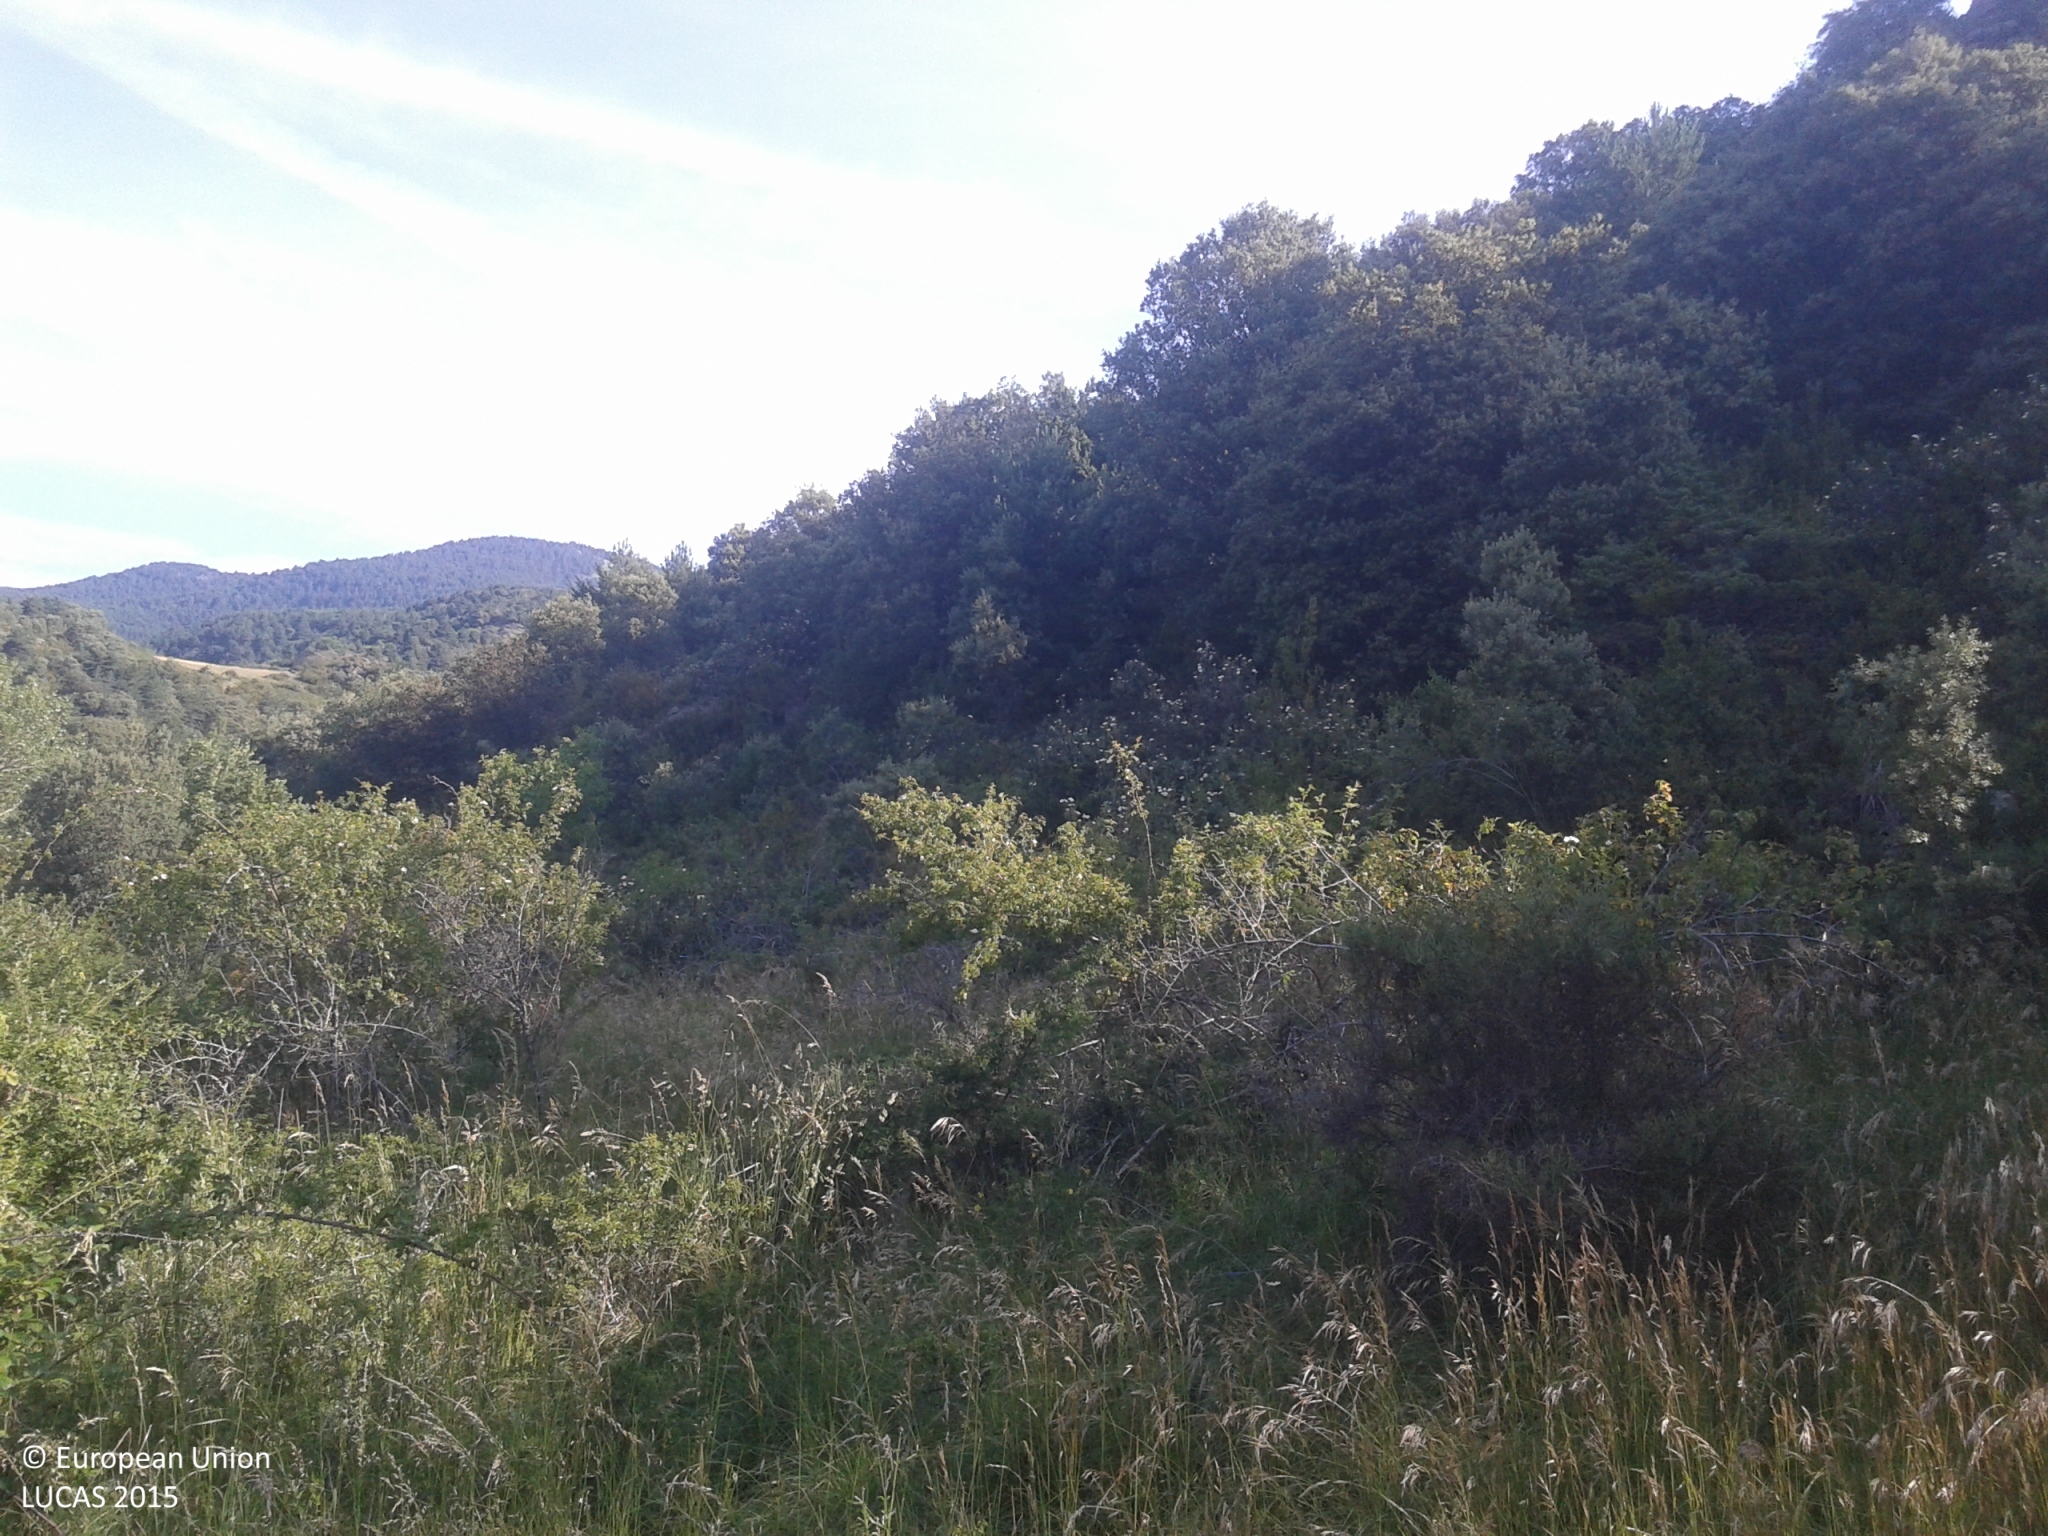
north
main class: Woodland
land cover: Pine dominated coniferous woodland
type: alpine coniferous forest
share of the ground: 25 - 50 %
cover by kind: shrubs 50 %, coniferous forest trees 30 %, unconsolidated bare surface 10 %, herbaceous plants 5 %, consolidated bare surface 5 %
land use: Semi-natural and natural areas not in use
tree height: > 5 m
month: June
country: ES
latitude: 42.3886
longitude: 1.5193
